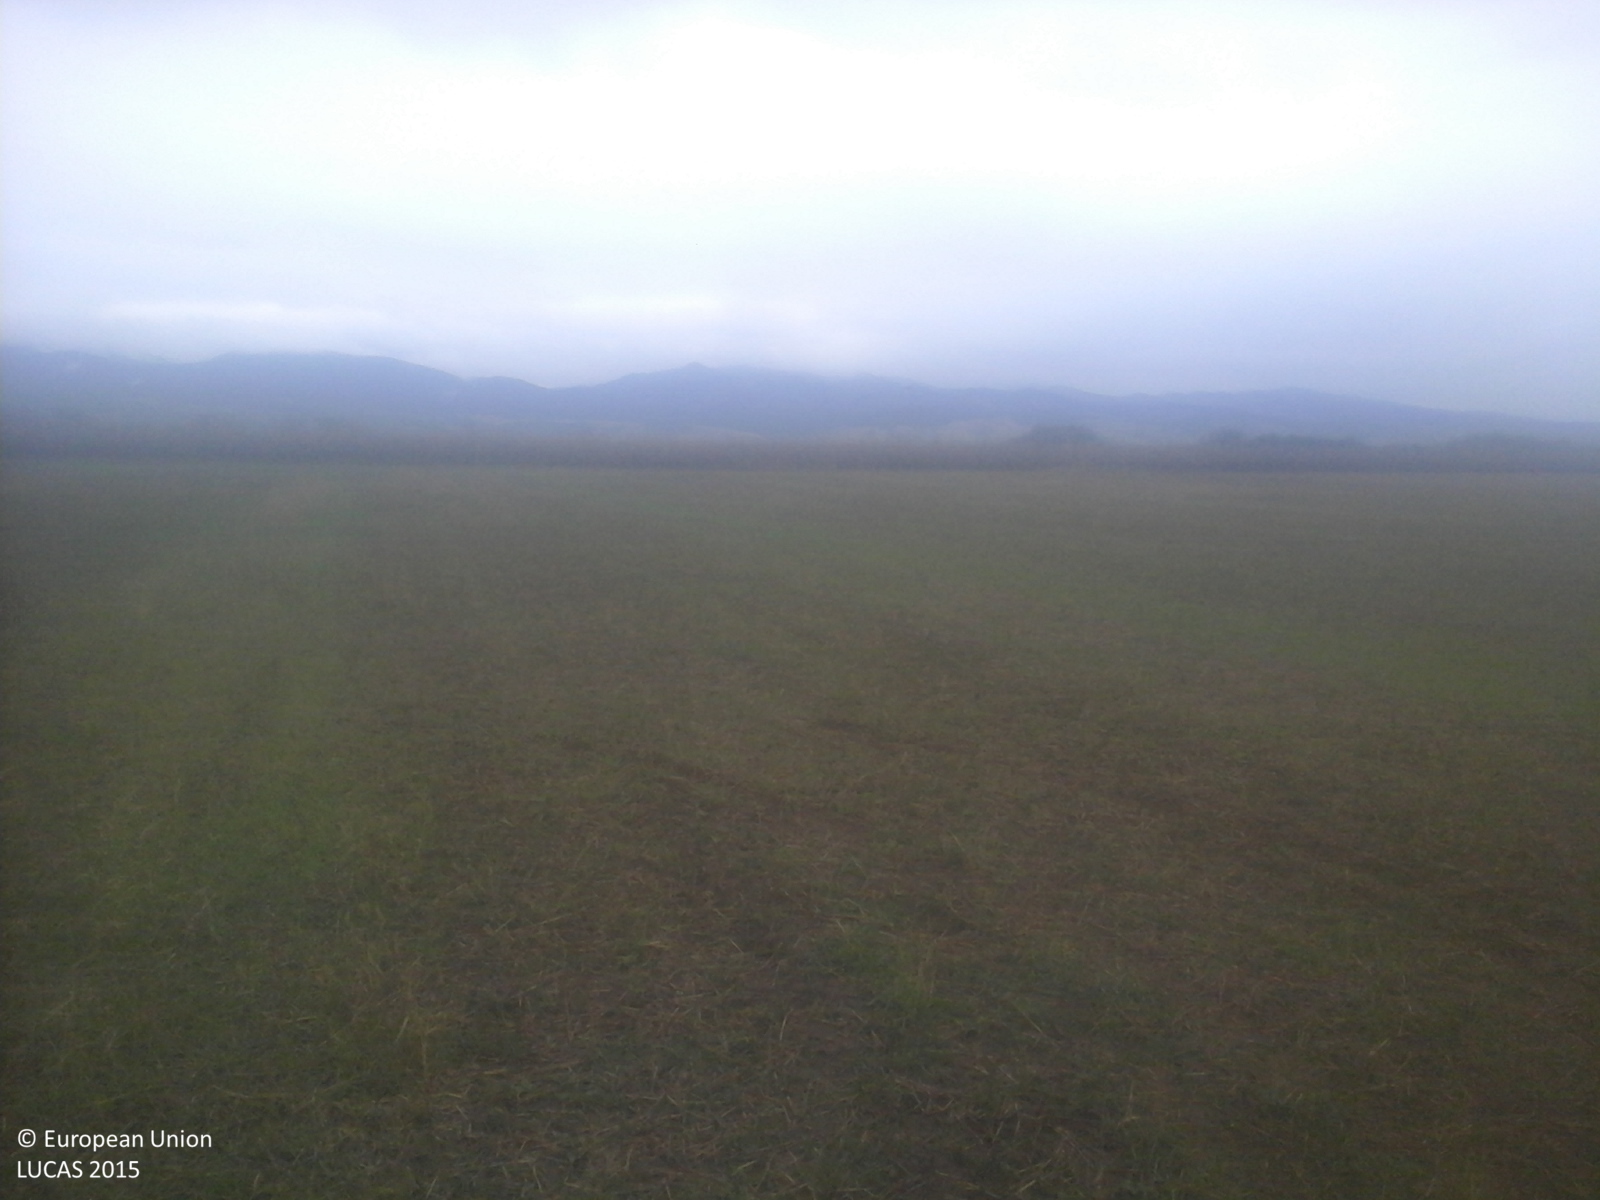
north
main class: Cropland
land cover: Common wheat
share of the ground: 25 - 50 %
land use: Agriculture (excluding fallow land and kitchen gardens)
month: September
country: RO
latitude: 45.9334
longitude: 23.4633
